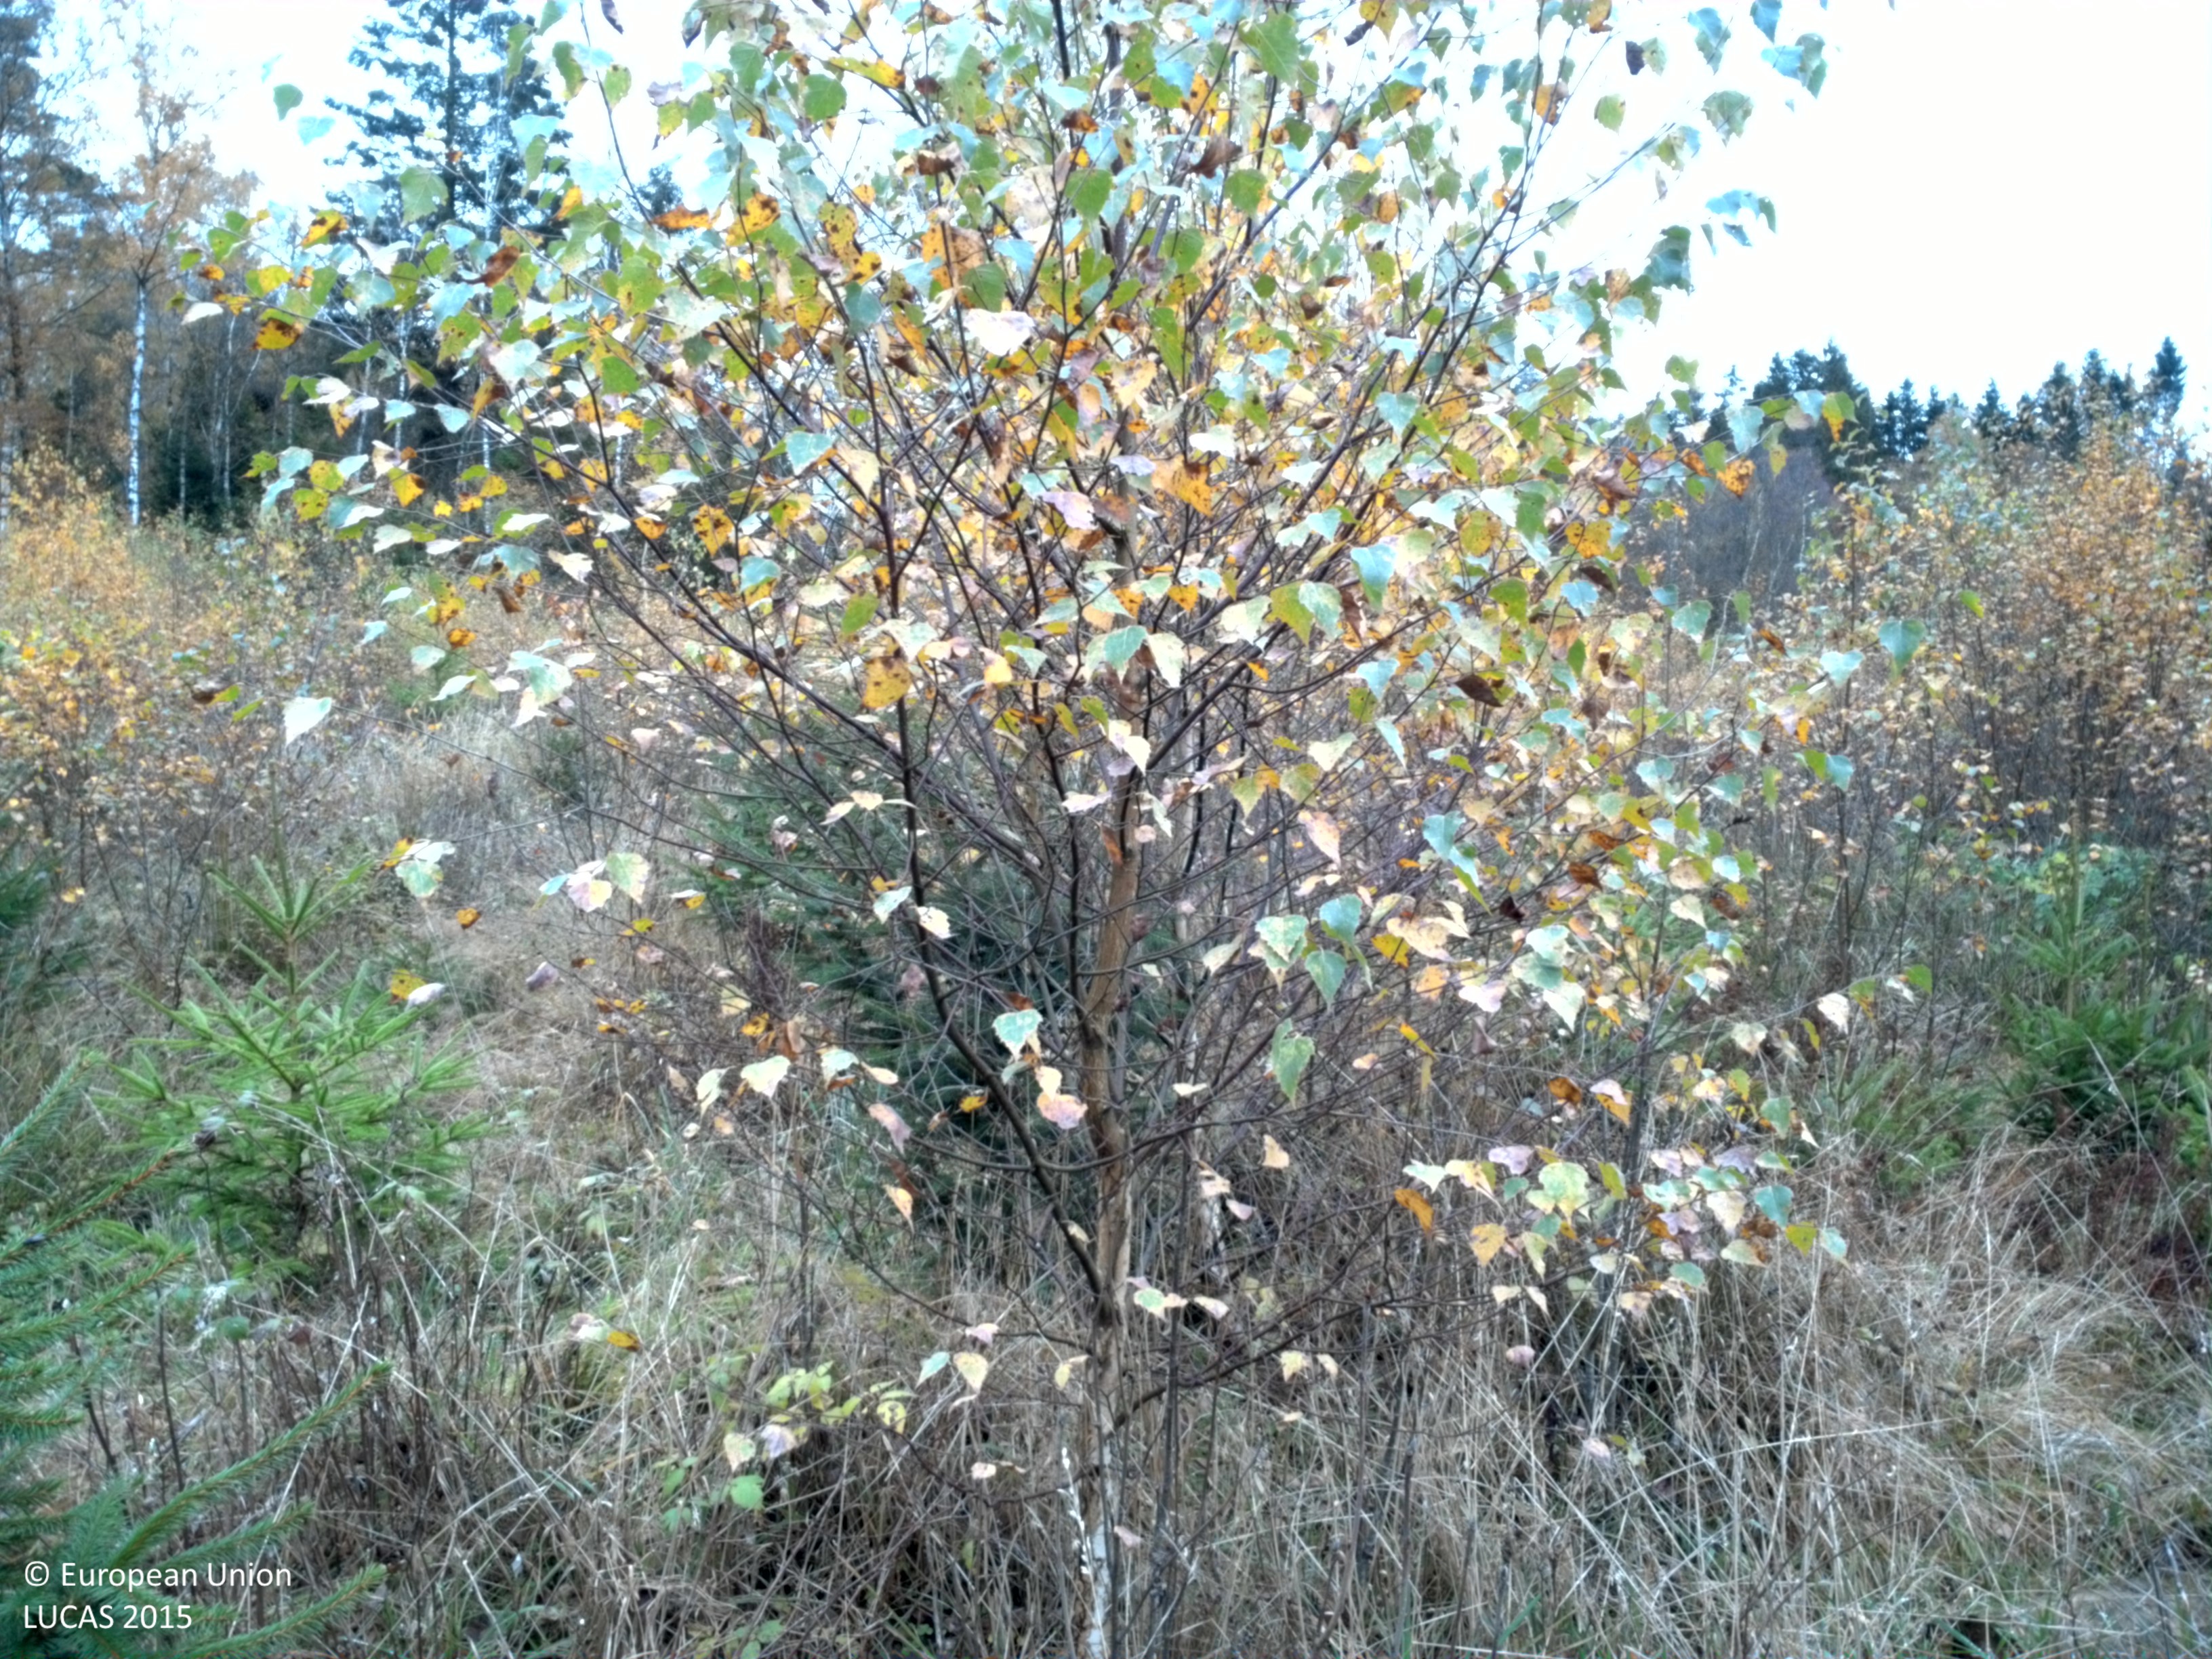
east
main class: Woodland
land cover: Other mixed woodland
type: hemiboreal forest and nemoral coniferous forest and mixed broadleaved-coniferous forest
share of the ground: 50 - 75 %
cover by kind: broadleaved forest trees 50 %, herbaceous plants 25 %, coniferous forest trees 20 %, shrubs 5 %
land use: Forestry
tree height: < 5 m
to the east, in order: Other mixed woodland; Rivers and streams; Other mixed woodland; Rivers and streams; Spruce dominated coniferous woodland; Ditches and canals; Spruce dominated coniferous woodland
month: October
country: SE
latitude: 55.9367
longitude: 13.6958
